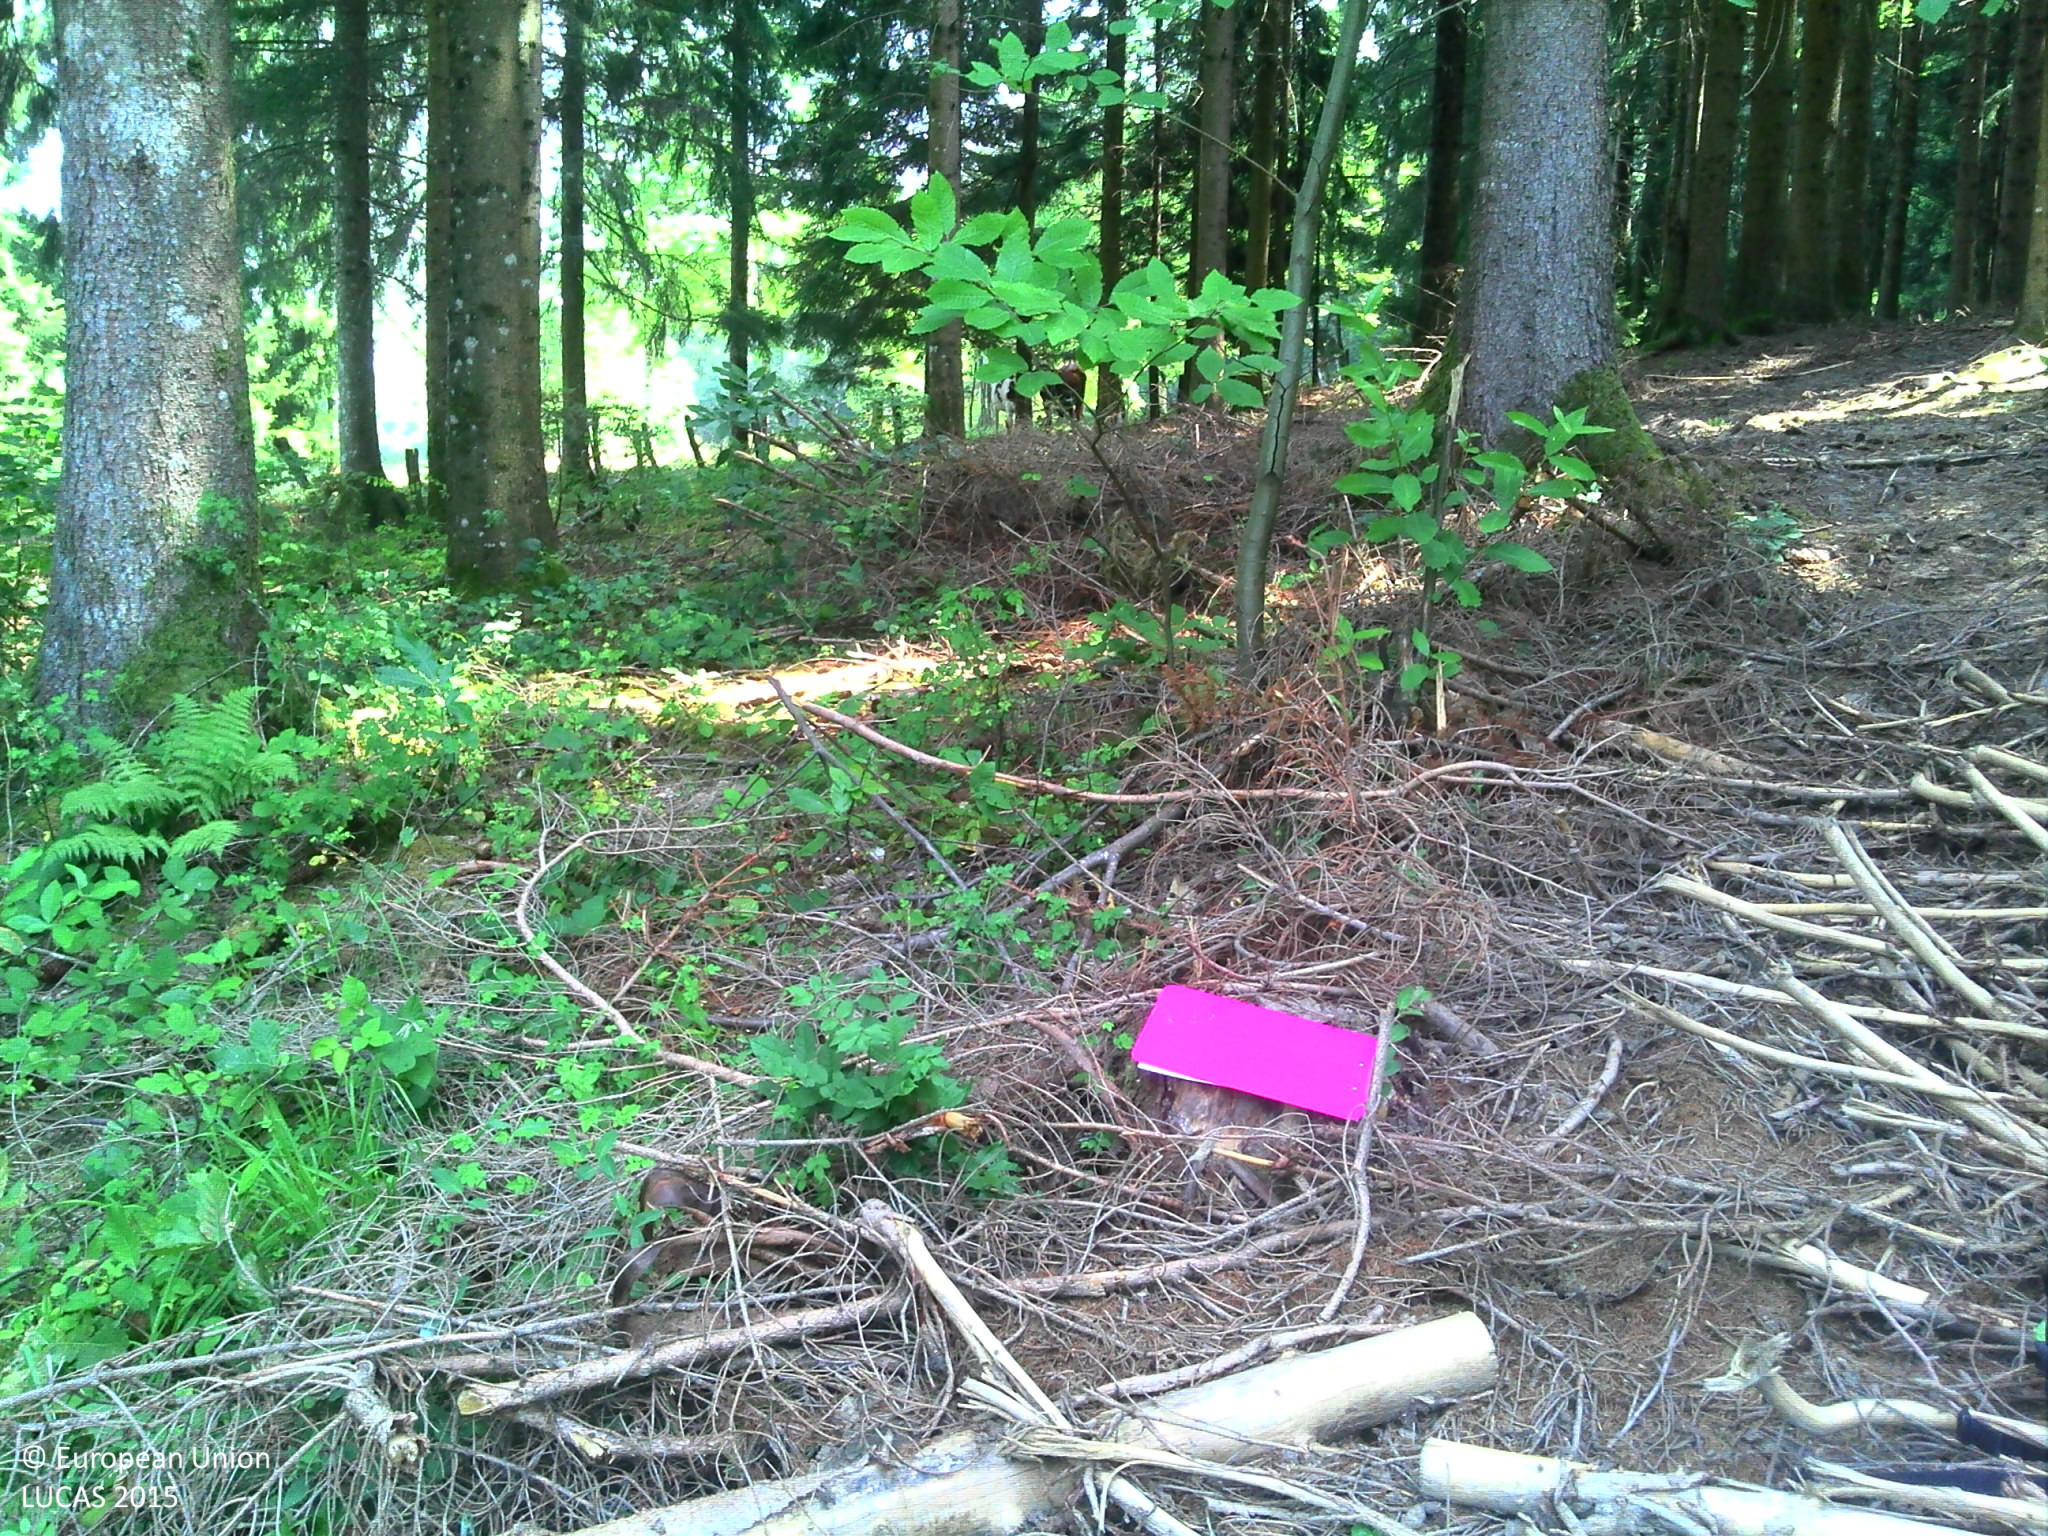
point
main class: Woodland
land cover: Spruce dominated coniferous woodland
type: alpine coniferous forest
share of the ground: > 75 %
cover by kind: coniferous forest trees 85 %, broadleaved forest trees 5 %, herbaceous plants 5 %, lichens and mosses 5 %
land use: Forestry
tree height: > 5 m
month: July
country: FR
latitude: 45.8133
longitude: 6.1562
